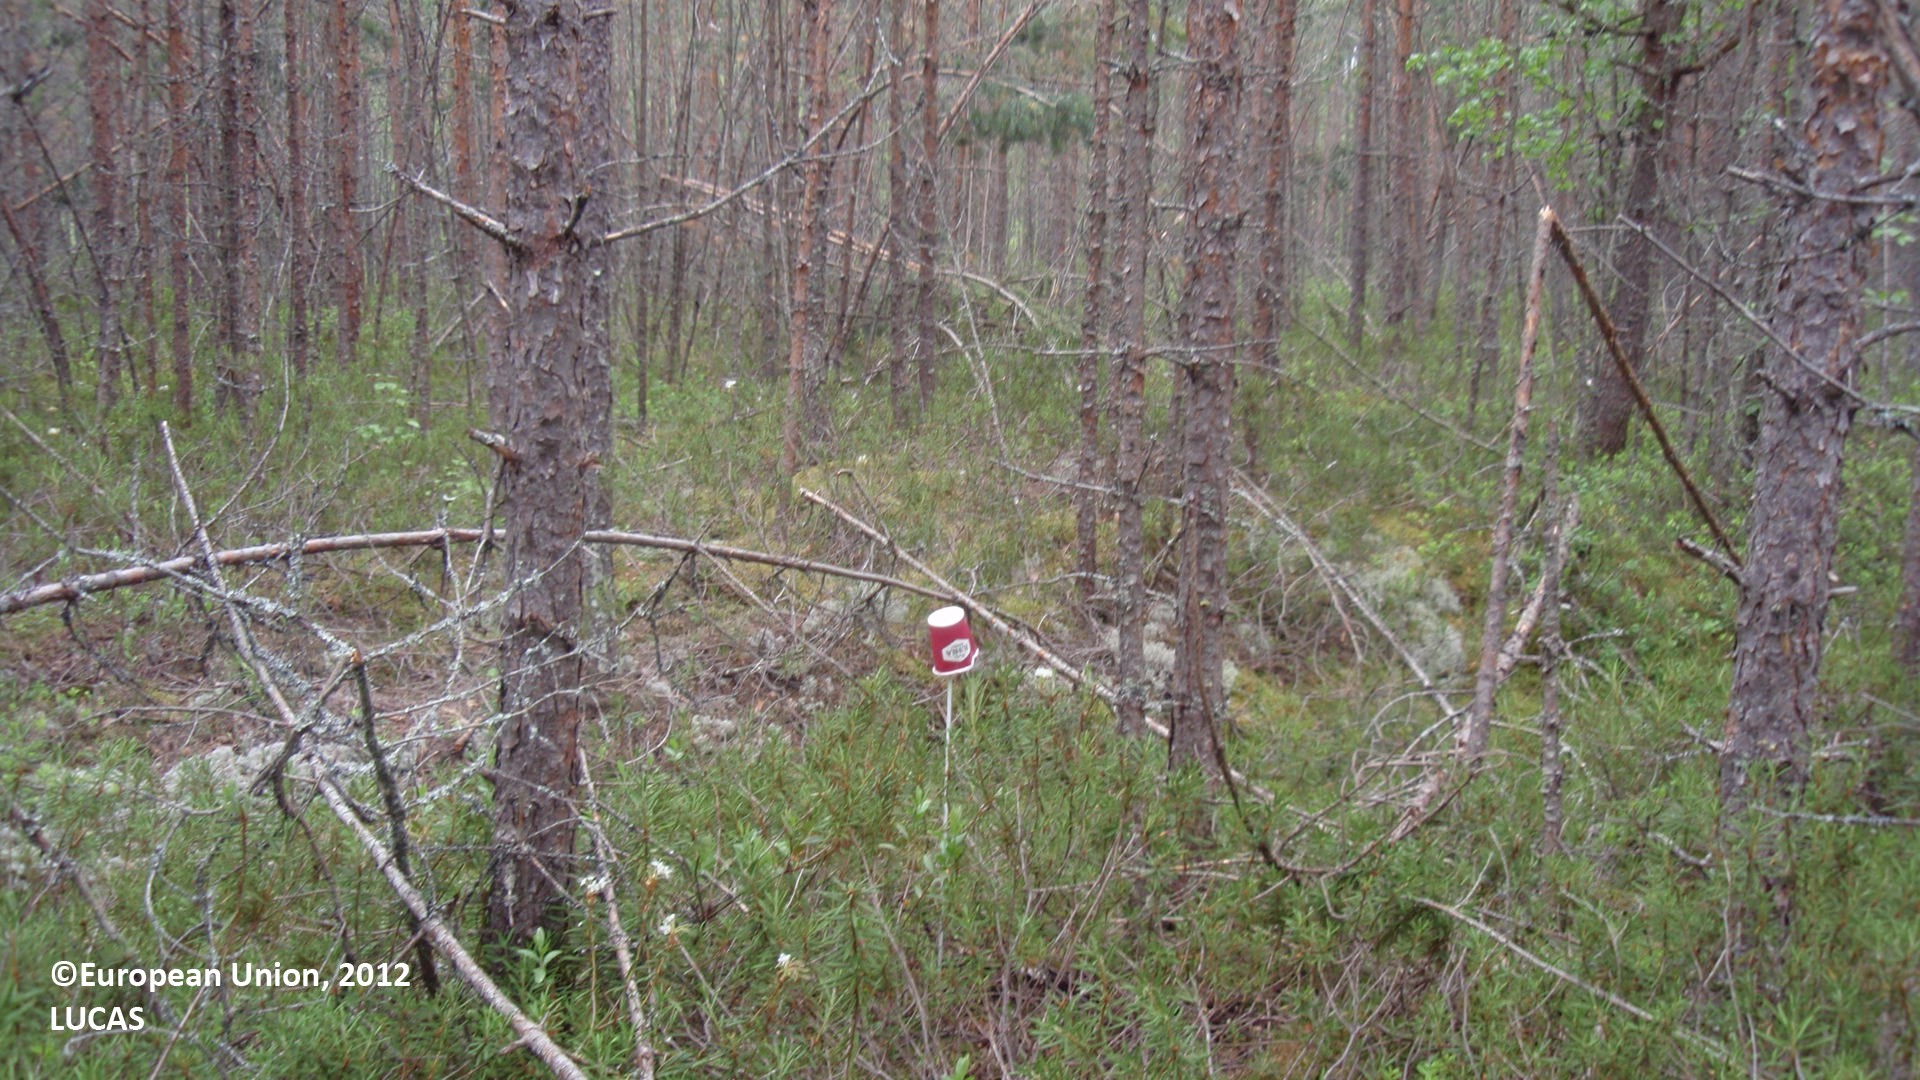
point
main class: Woodland
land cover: Pine dominated coniferous woodland
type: boreal forest
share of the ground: > 75 %
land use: Forestry
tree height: > 5 m
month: June
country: FI
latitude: 61.0891
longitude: 26.7542
